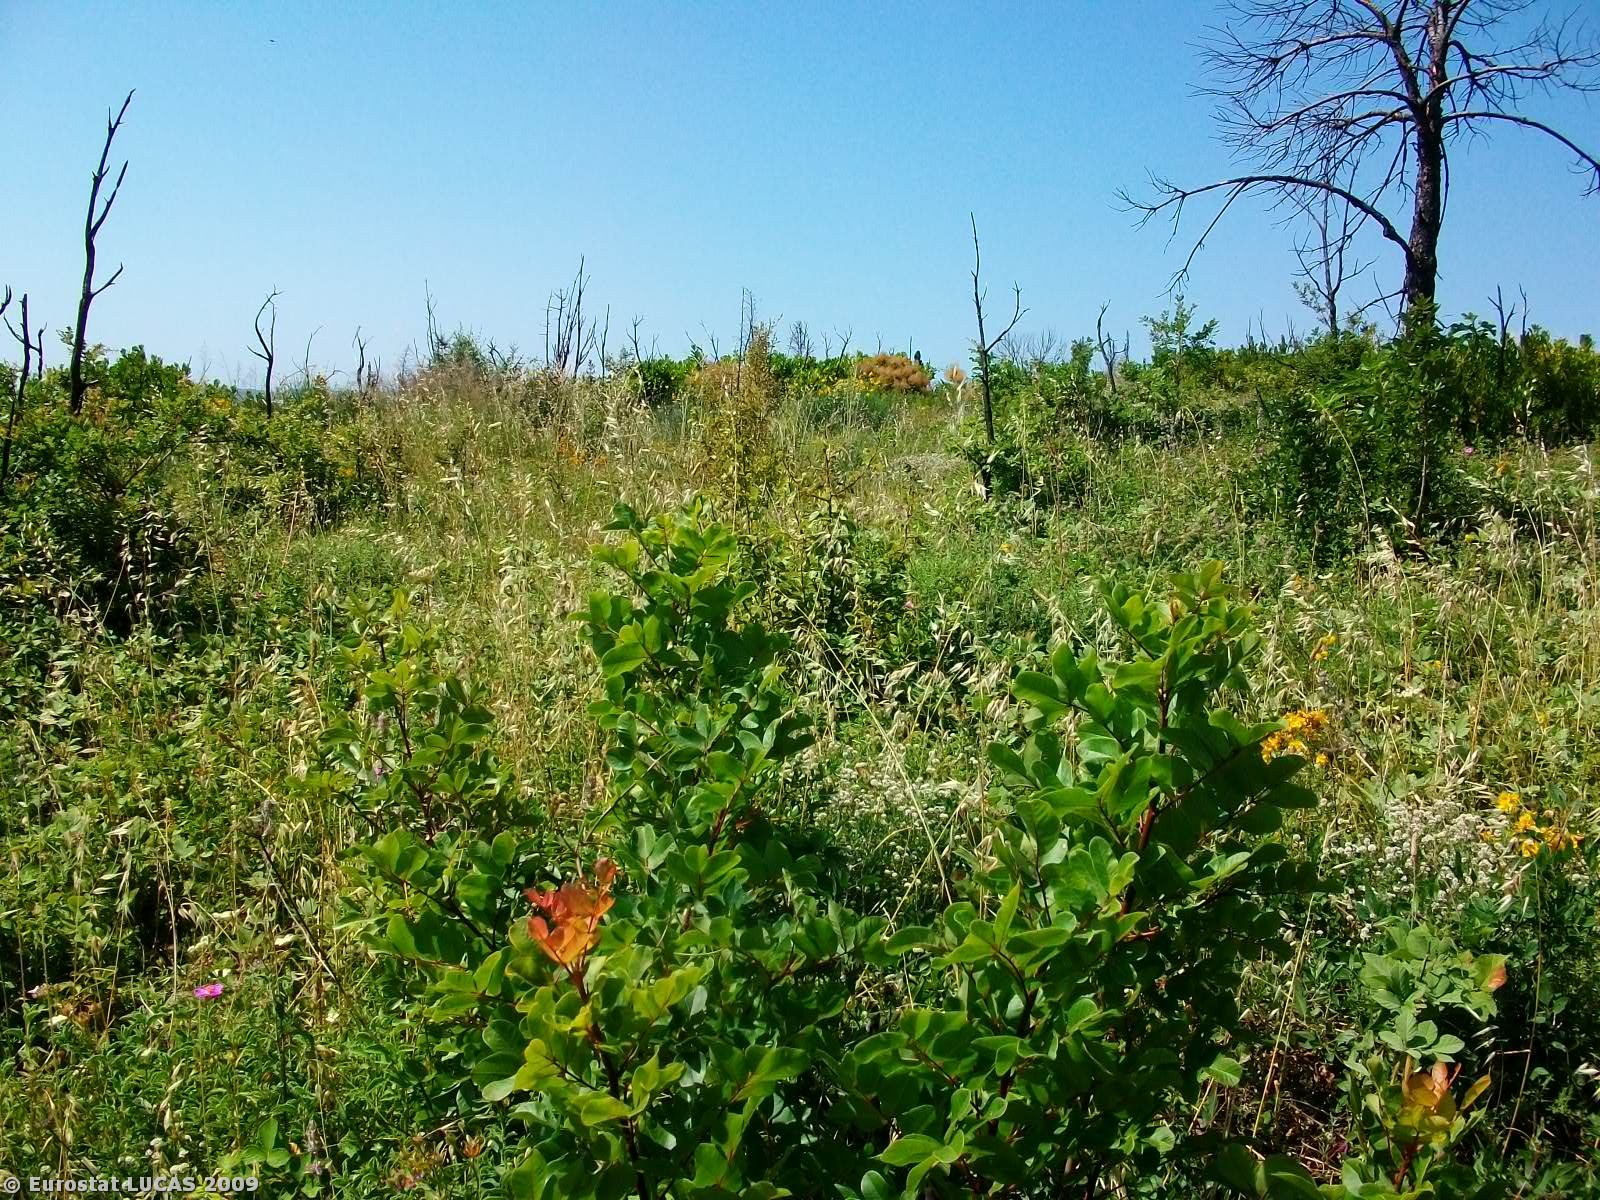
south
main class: Grassland
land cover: Grassland with sparse tree/shrub cover
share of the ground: > 75 %
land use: Unused
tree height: < 5 m
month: June
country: GR
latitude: 39.2884
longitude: 23.2689
